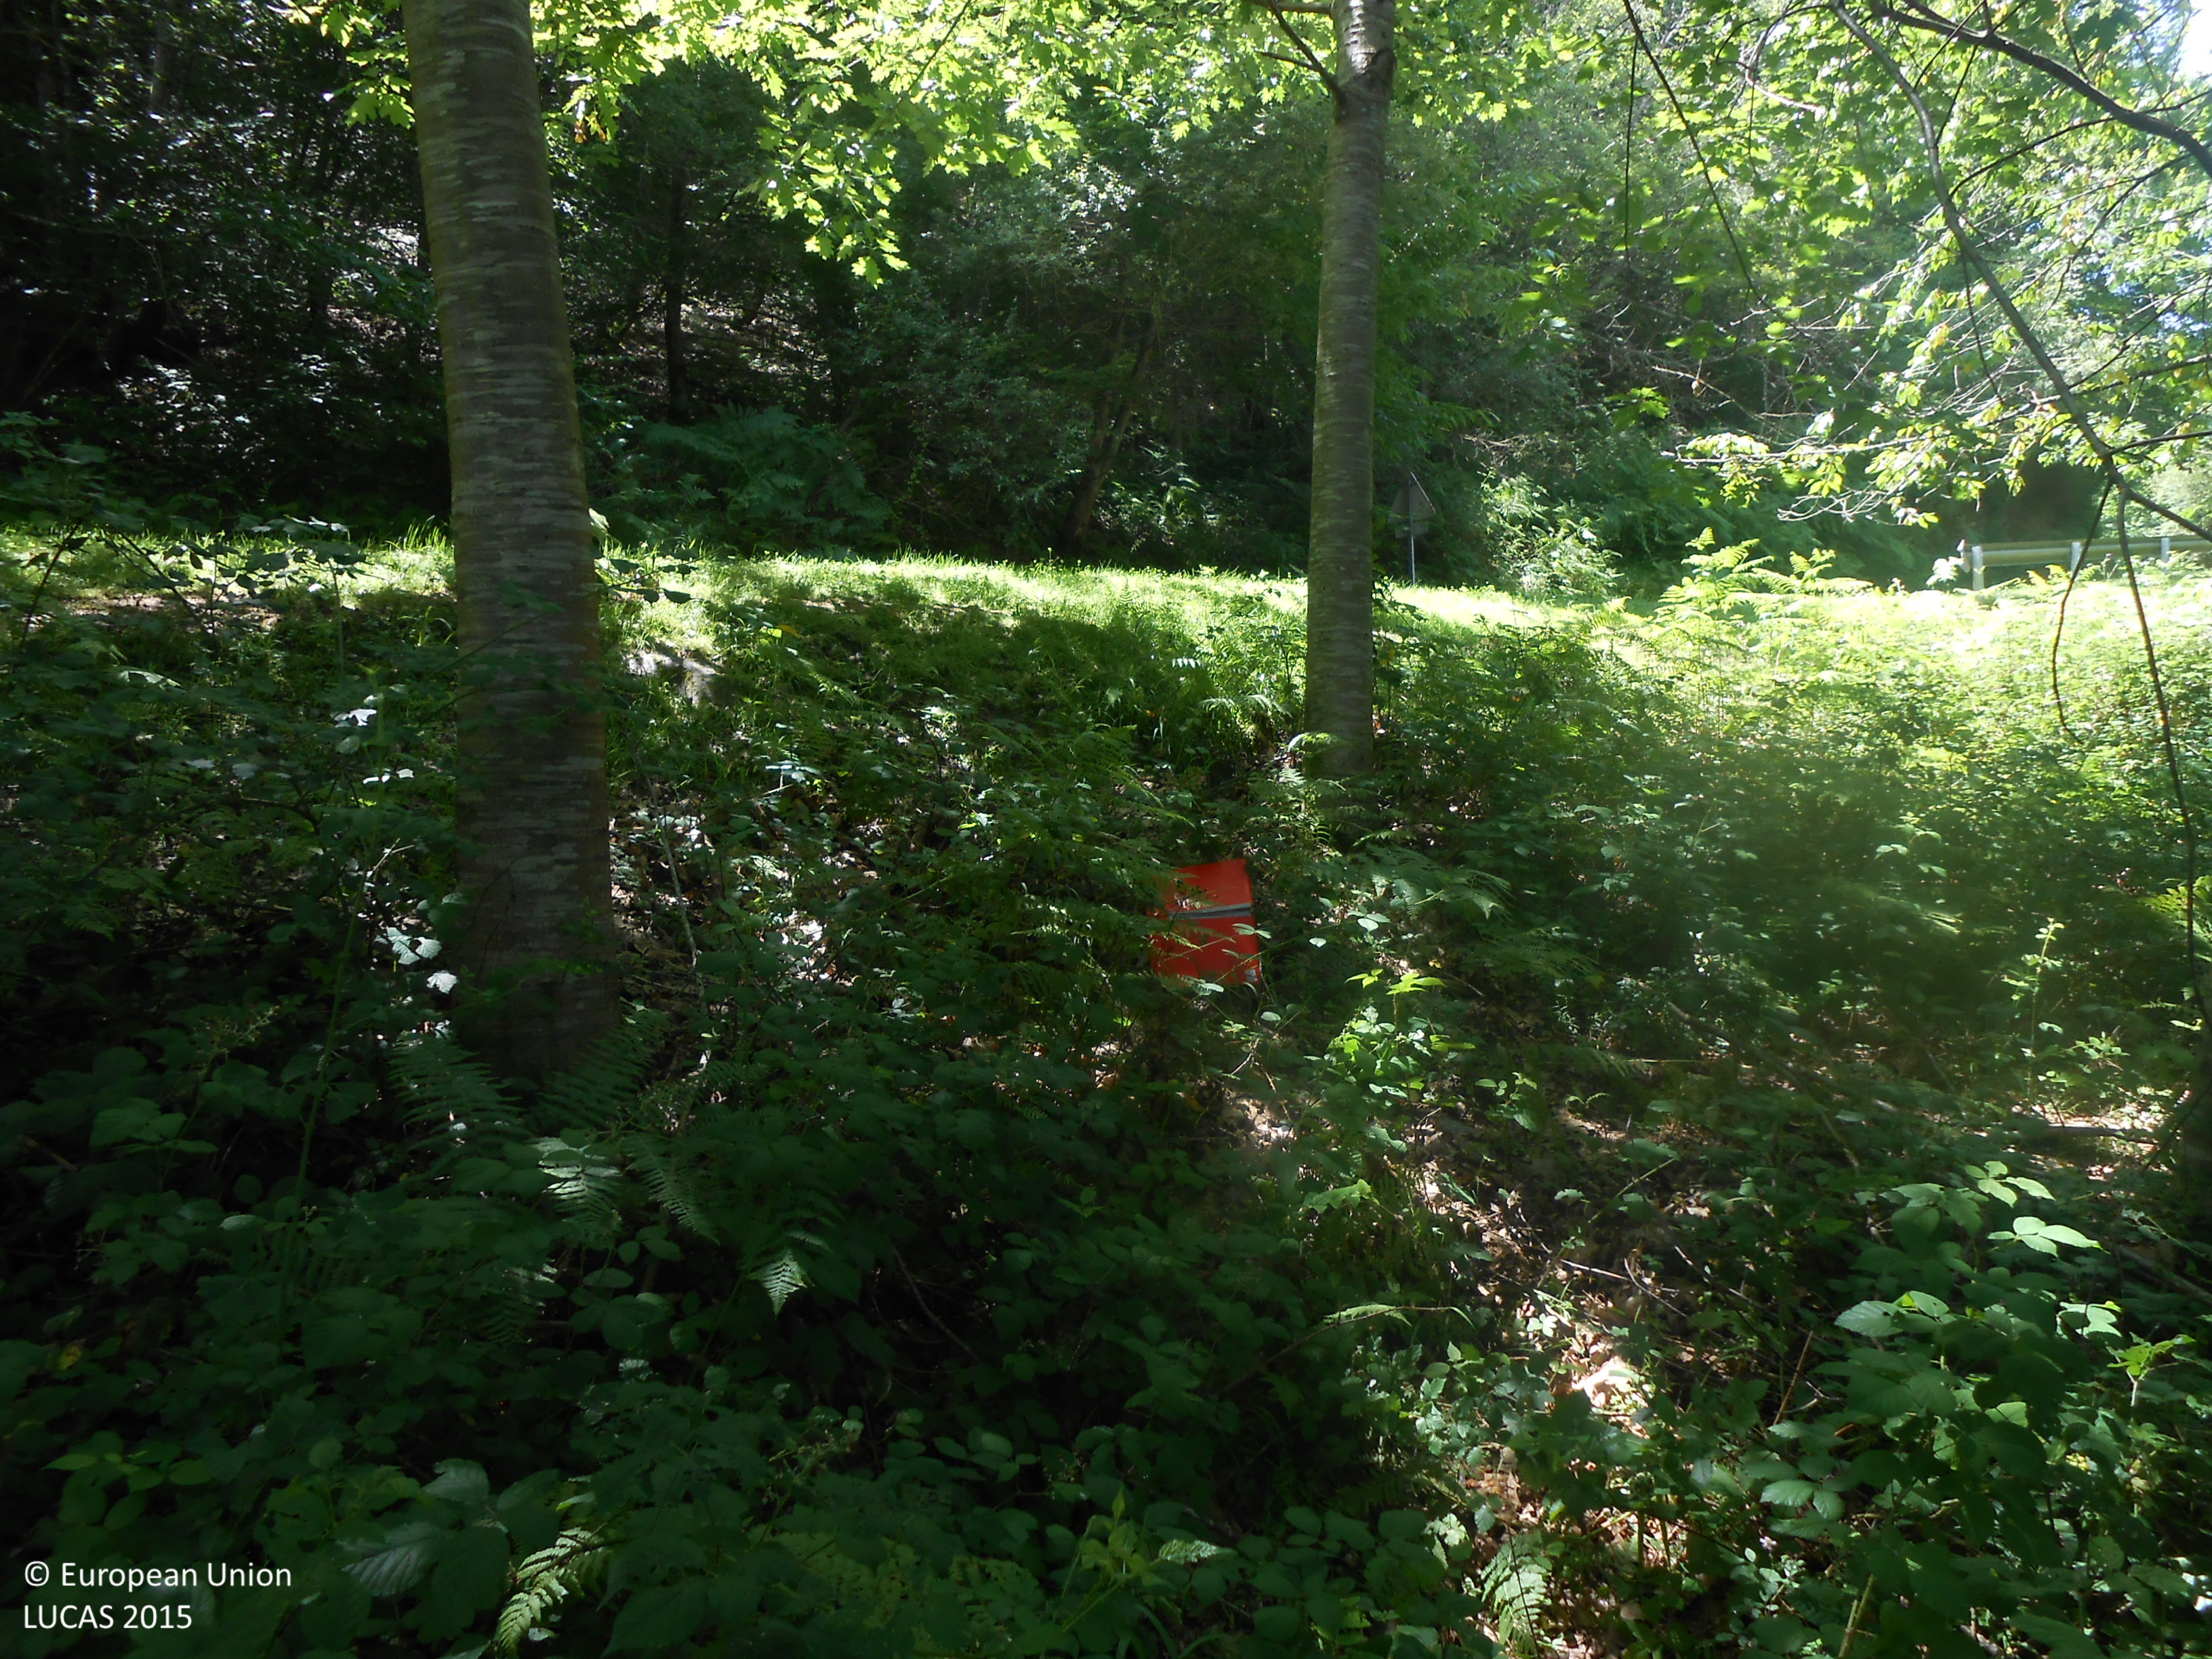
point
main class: Woodland
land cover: Broadleaved woodland
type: acidophilous oak and oak-birch forest
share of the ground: > 75 %
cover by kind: broadleaved forest trees 95 %, herbaceous plants 5 %
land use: Forestry
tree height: > 5 m
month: June
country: ES
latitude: 43.1910
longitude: -1.5713
